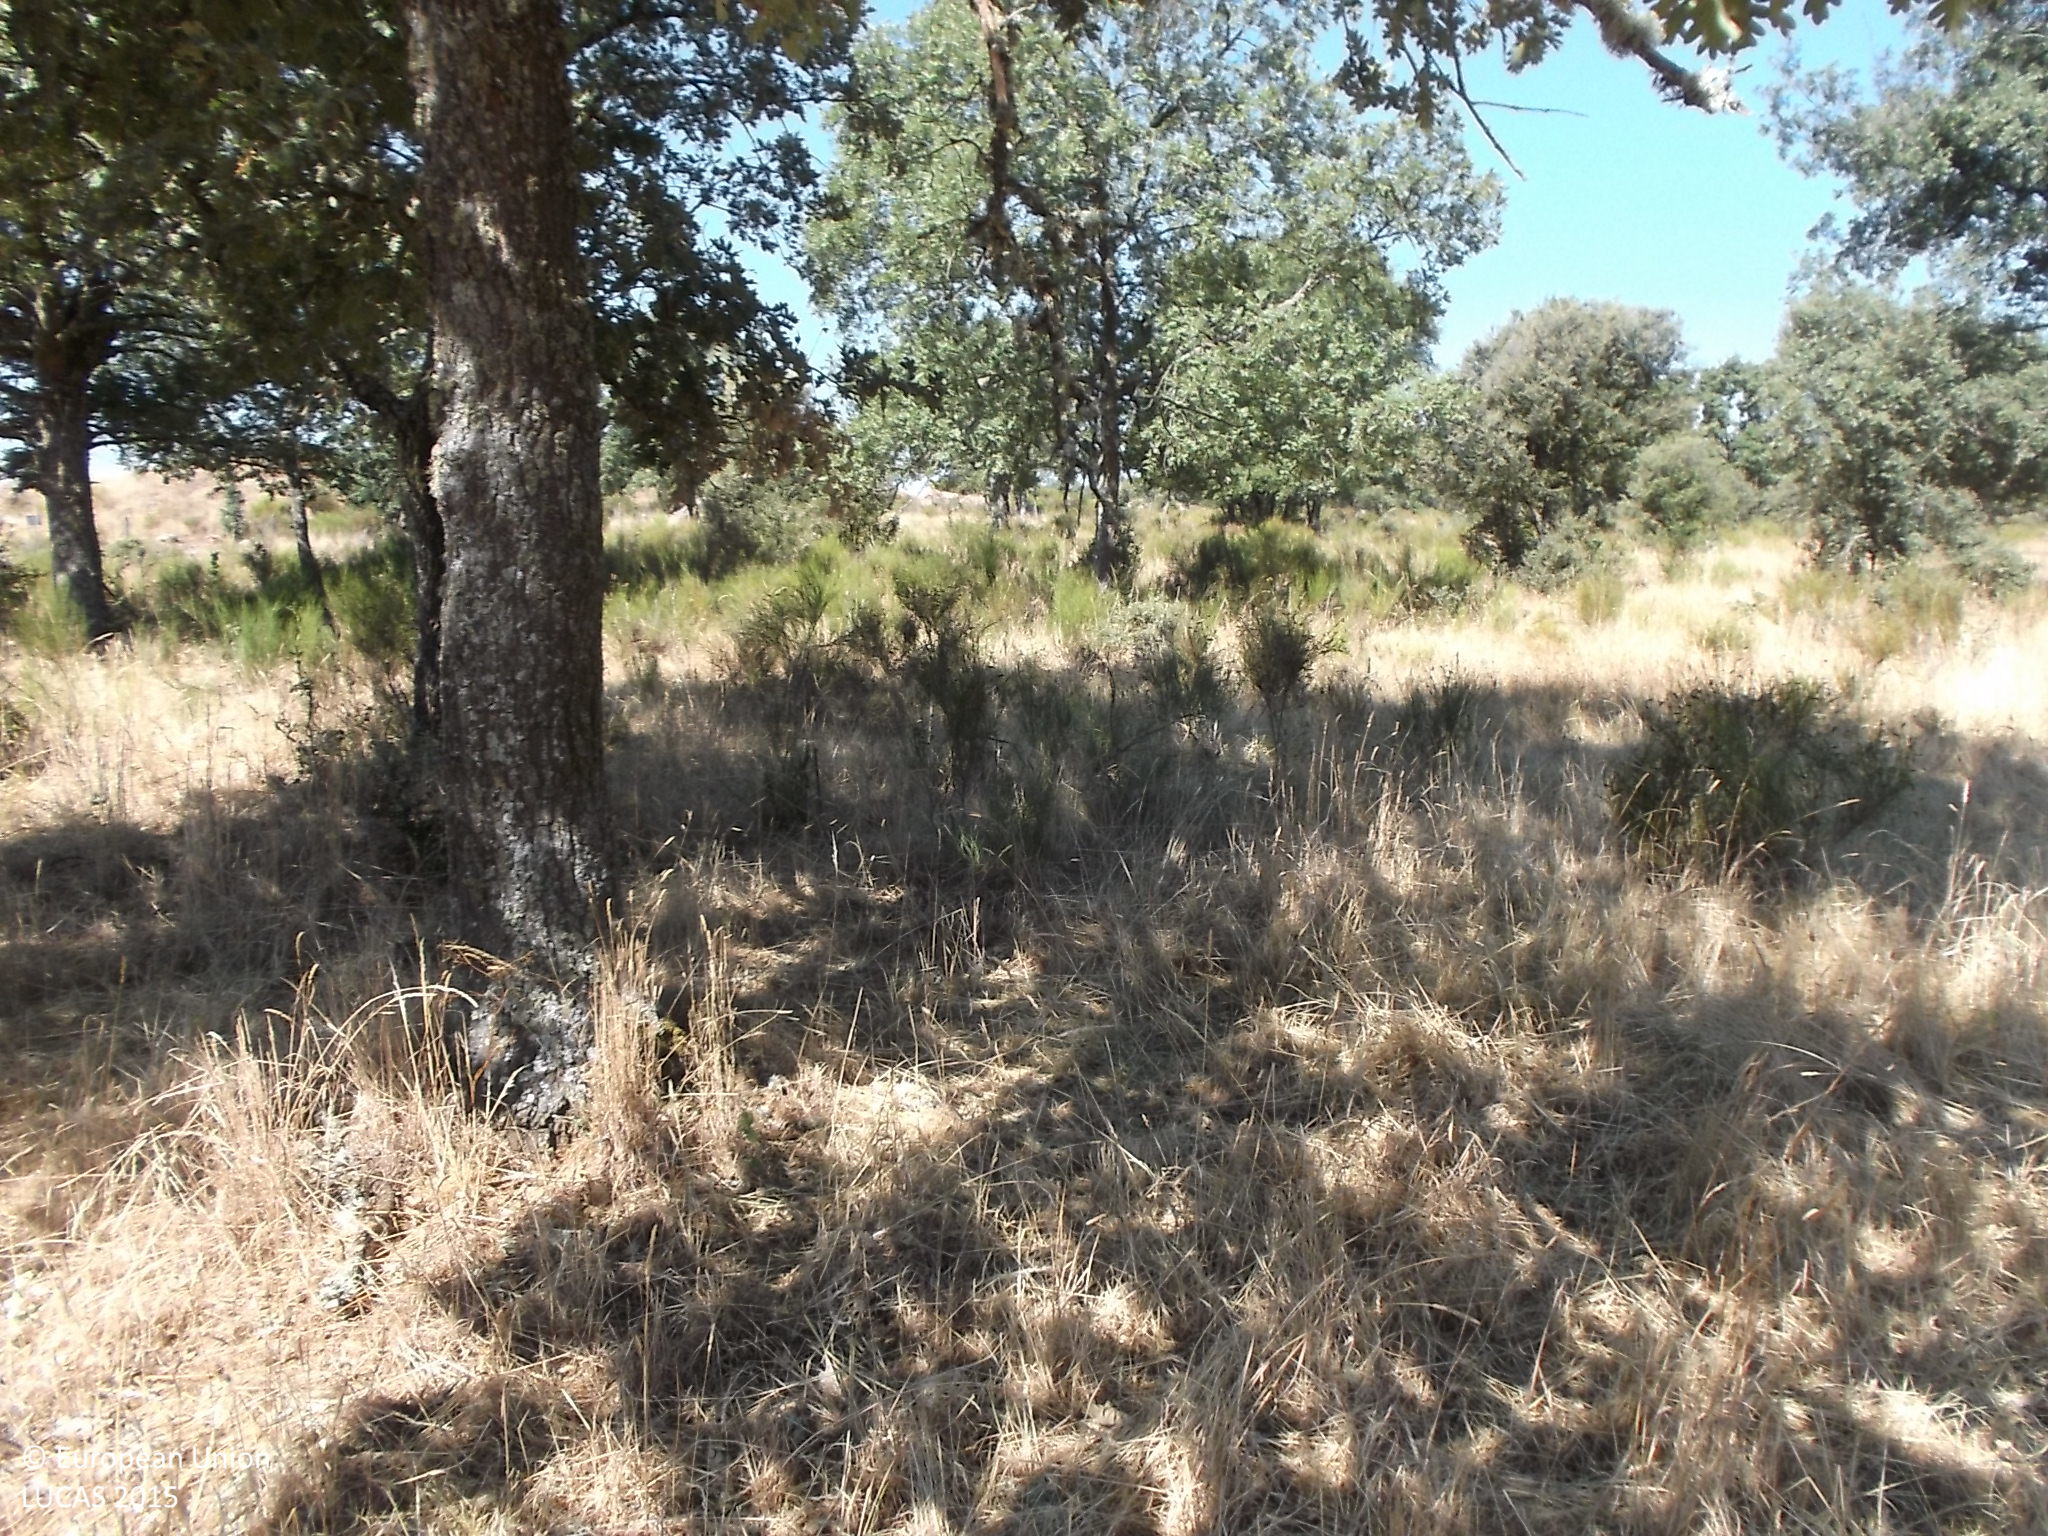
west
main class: Woodland
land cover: Broadleaved woodland
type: broadleaved evergreen forest
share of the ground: 10 - 25 %
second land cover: Shrubland without tree cover
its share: 25 - 50 %
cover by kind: shrubs 40 %, herbaceous plants 35 %, broadleaved forest trees 25 %
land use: Forestry
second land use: Agriculture (excluding fallow land and kitchen gardens)
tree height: < 5 m
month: July
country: ES
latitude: 41.3543
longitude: -5.9987
